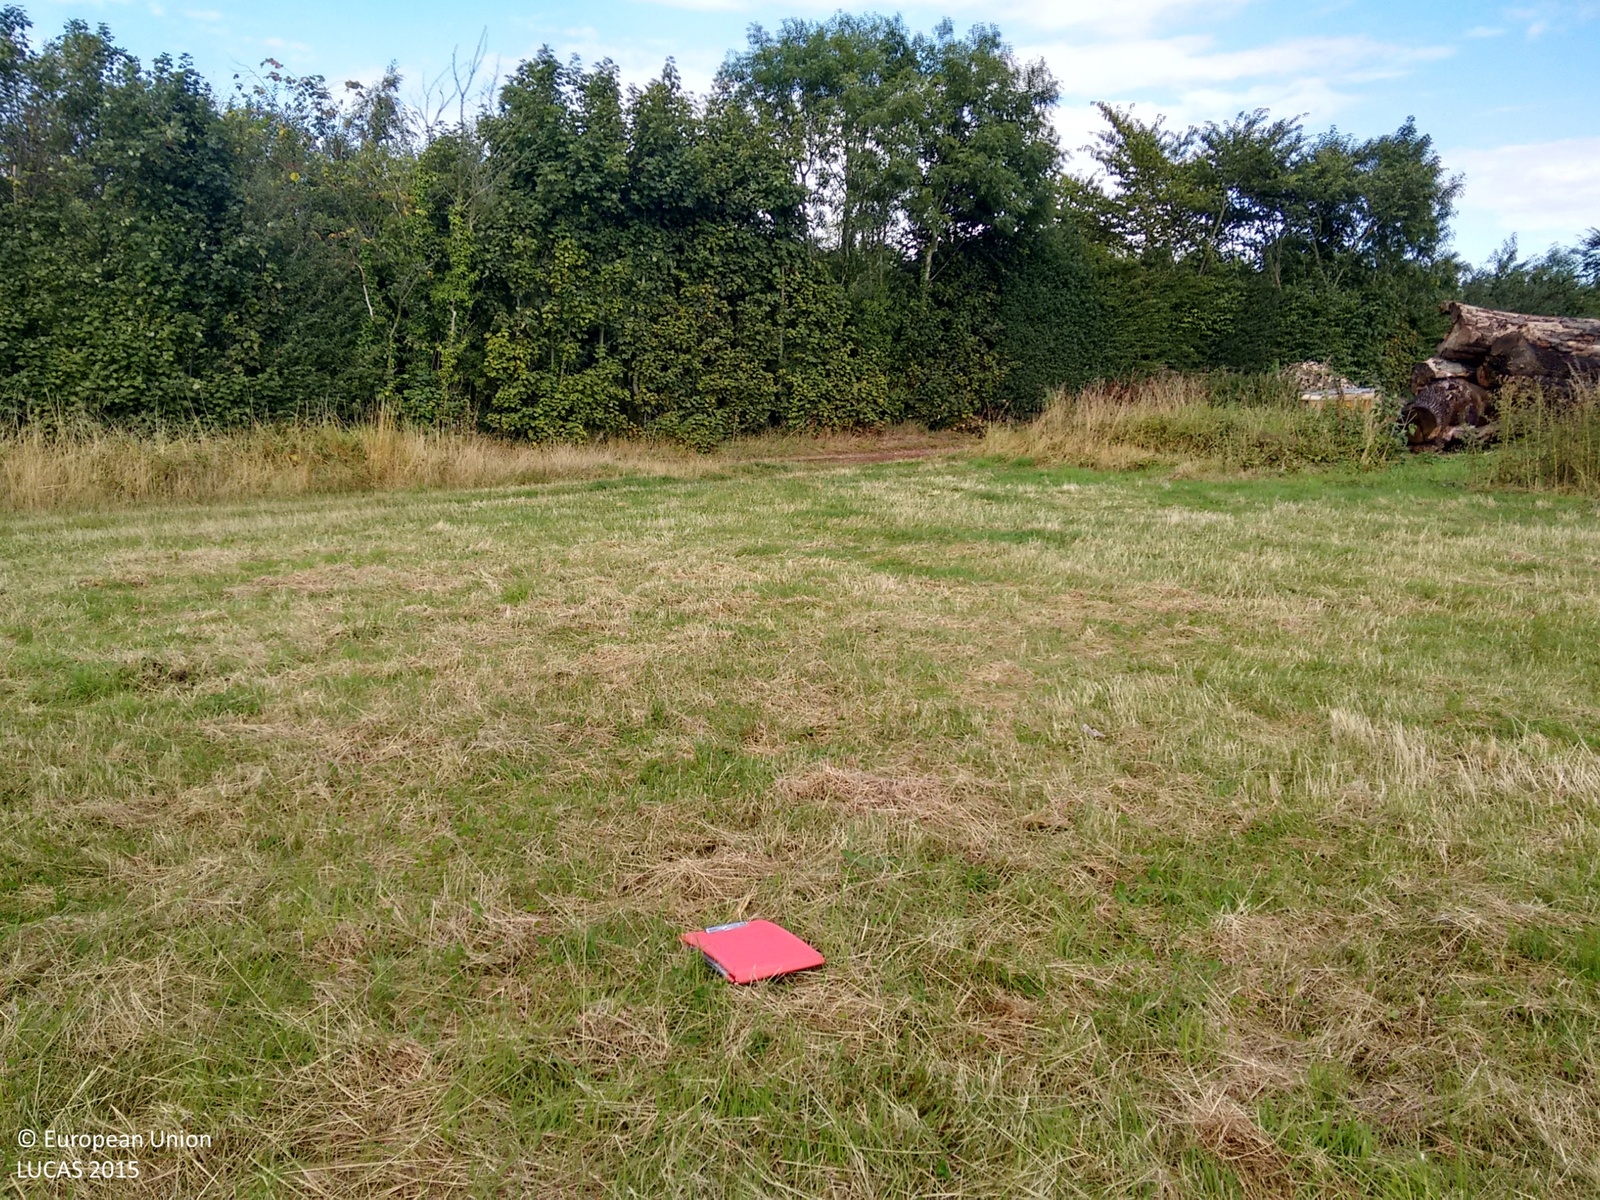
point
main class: Grassland
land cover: Grassland without tree/shrub cover
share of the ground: > 75 %
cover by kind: herbaceous plants 100 %
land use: Agriculture (excluding fallow land and kitchen gardens)
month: September
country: GB
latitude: 52.7960
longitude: -1.5151
